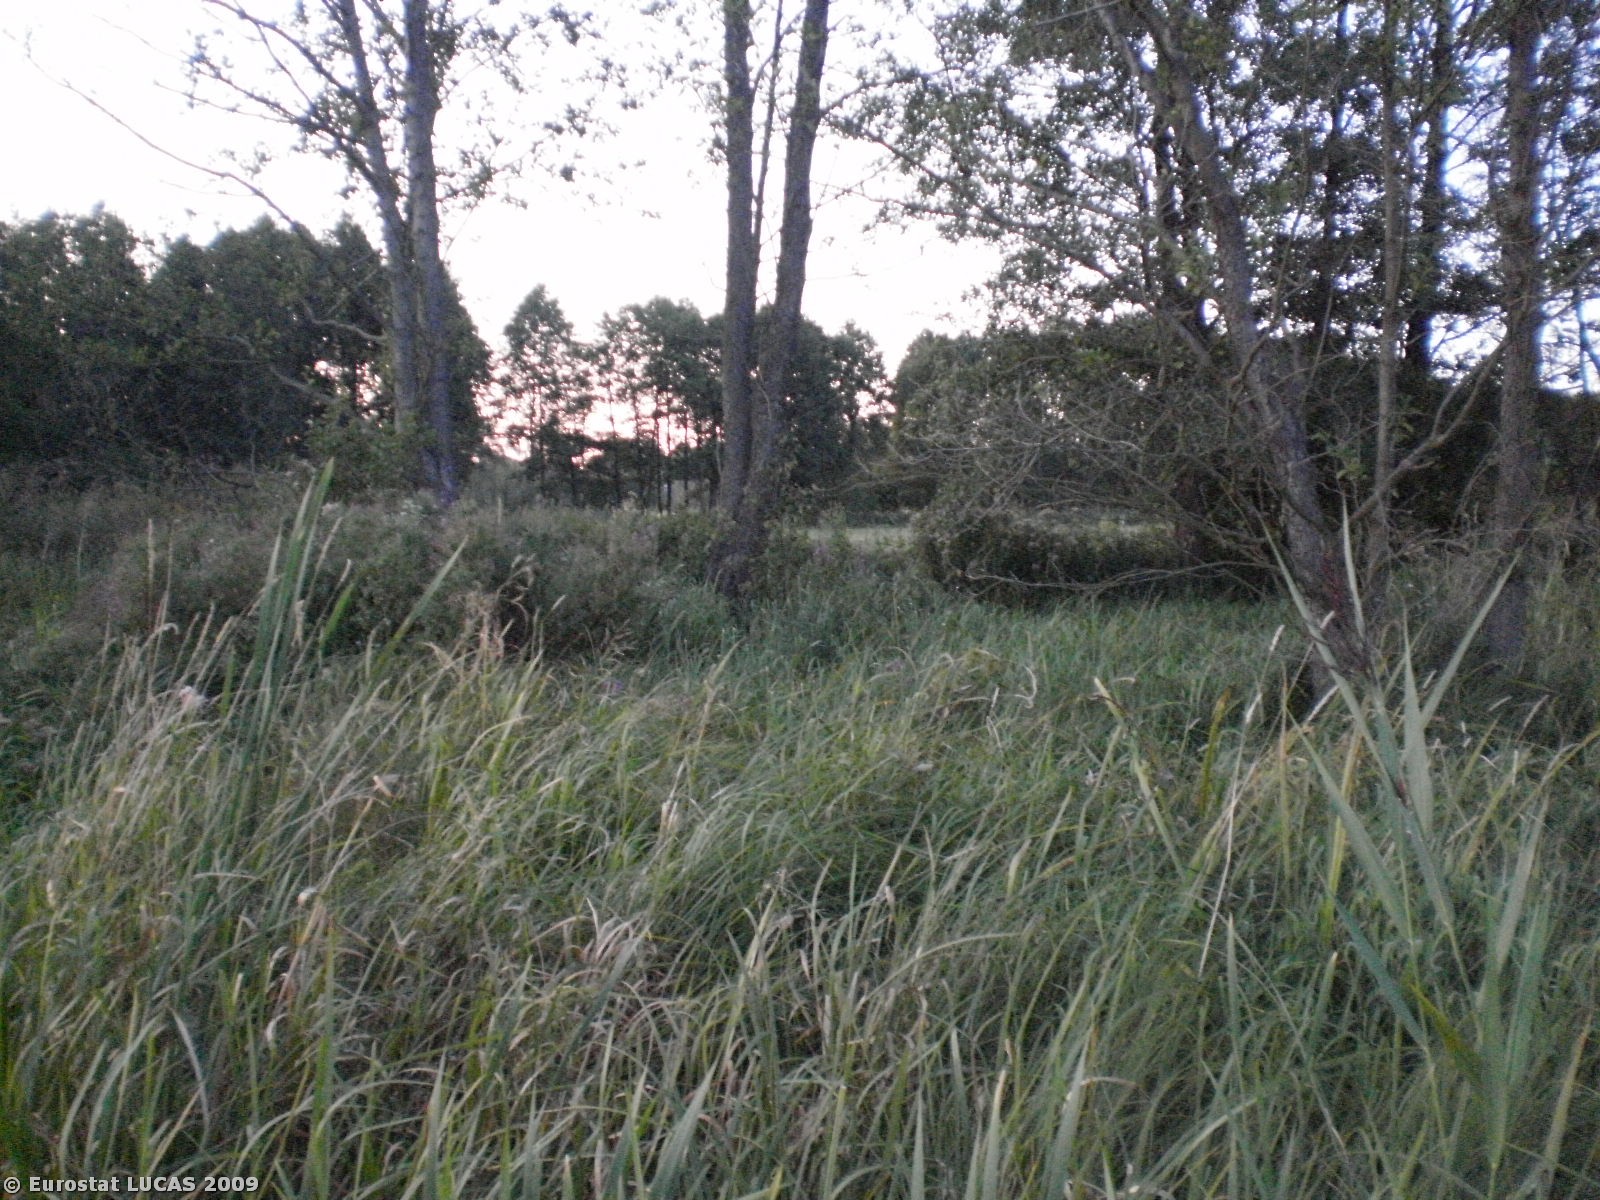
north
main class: Woodland
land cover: Broadleaved woodland
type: mire and swamp forests
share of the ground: 50 - 75 %
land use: Unused
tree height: > 5 m
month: August
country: PL
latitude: 53.3747
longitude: 21.9159
